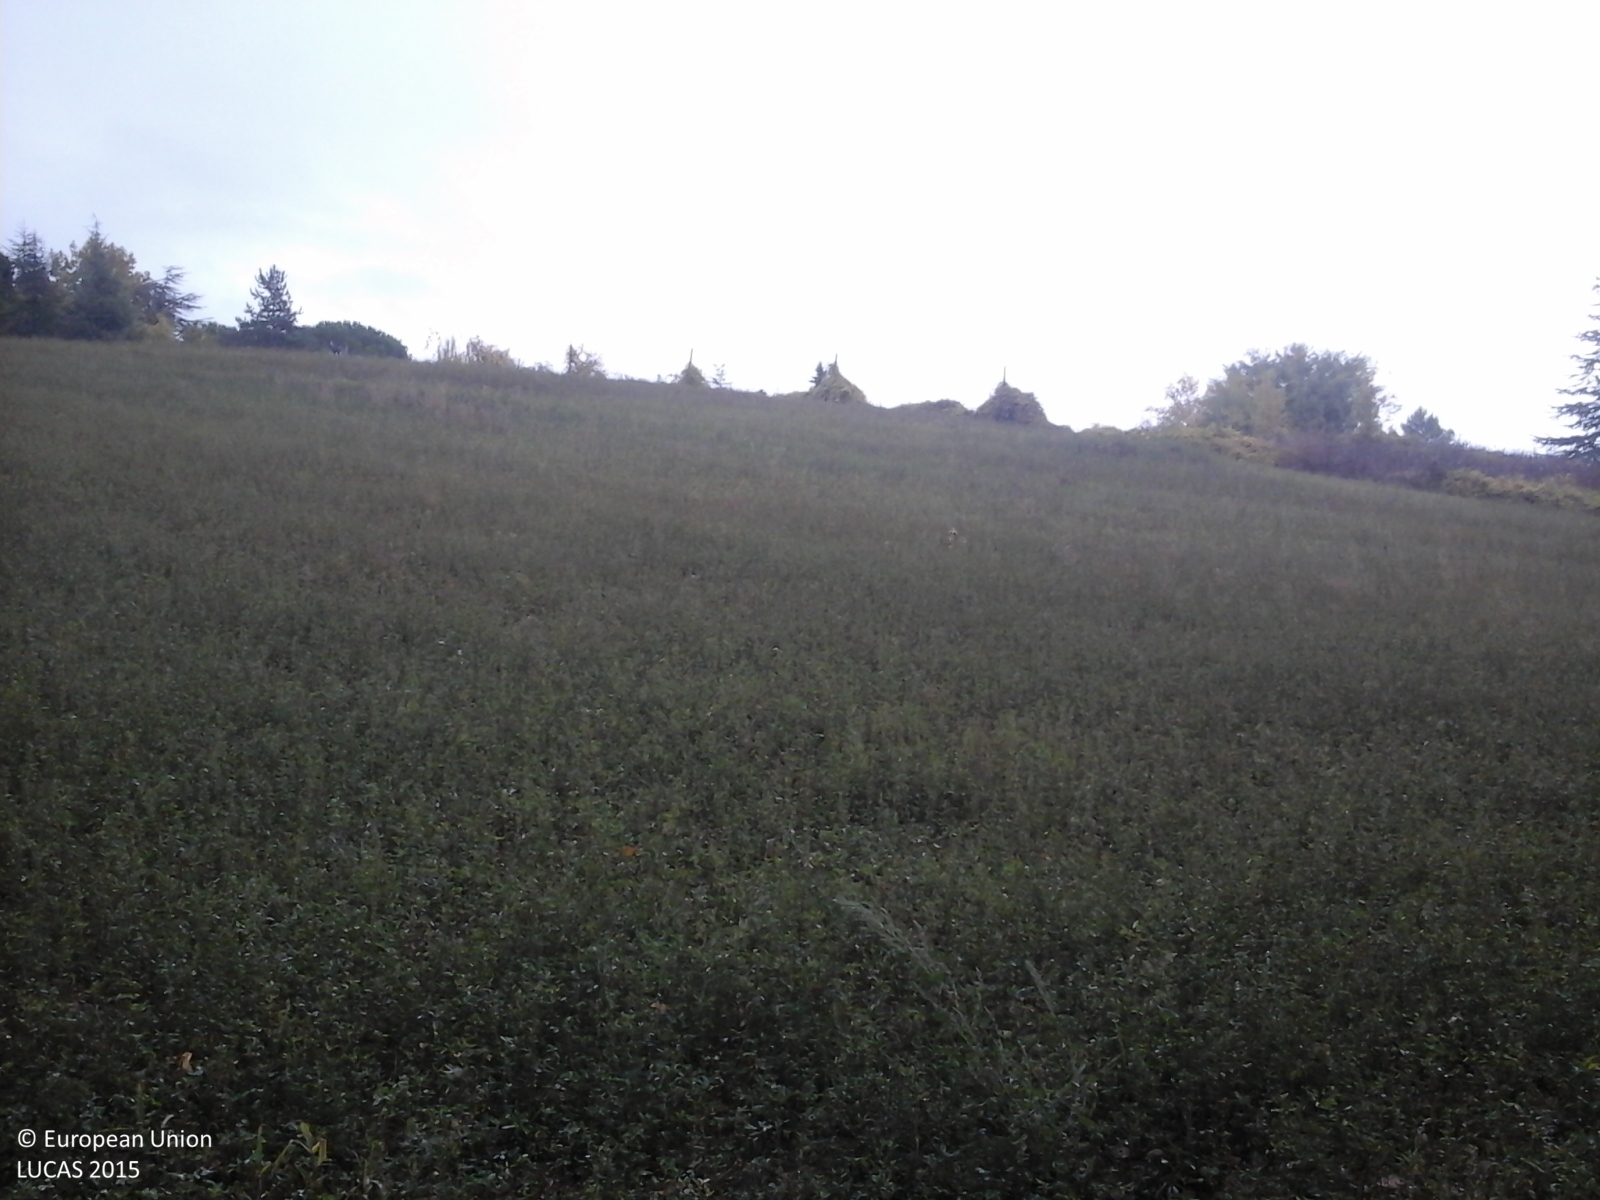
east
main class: Woodland
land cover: Broadleaved woodland
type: floodplain forest
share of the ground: > 75 %
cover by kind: broadleaved forest trees 90 %, shrubs 10 %
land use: Forestry
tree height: > 5 m
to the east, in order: Broadleaved woodland; Spontaneously vegetated surfaces; Shruby margins; Spontaneously vegetated surfaces; Vineyards; Sunflower
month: October
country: IT
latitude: 43.3498
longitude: 12.3253
